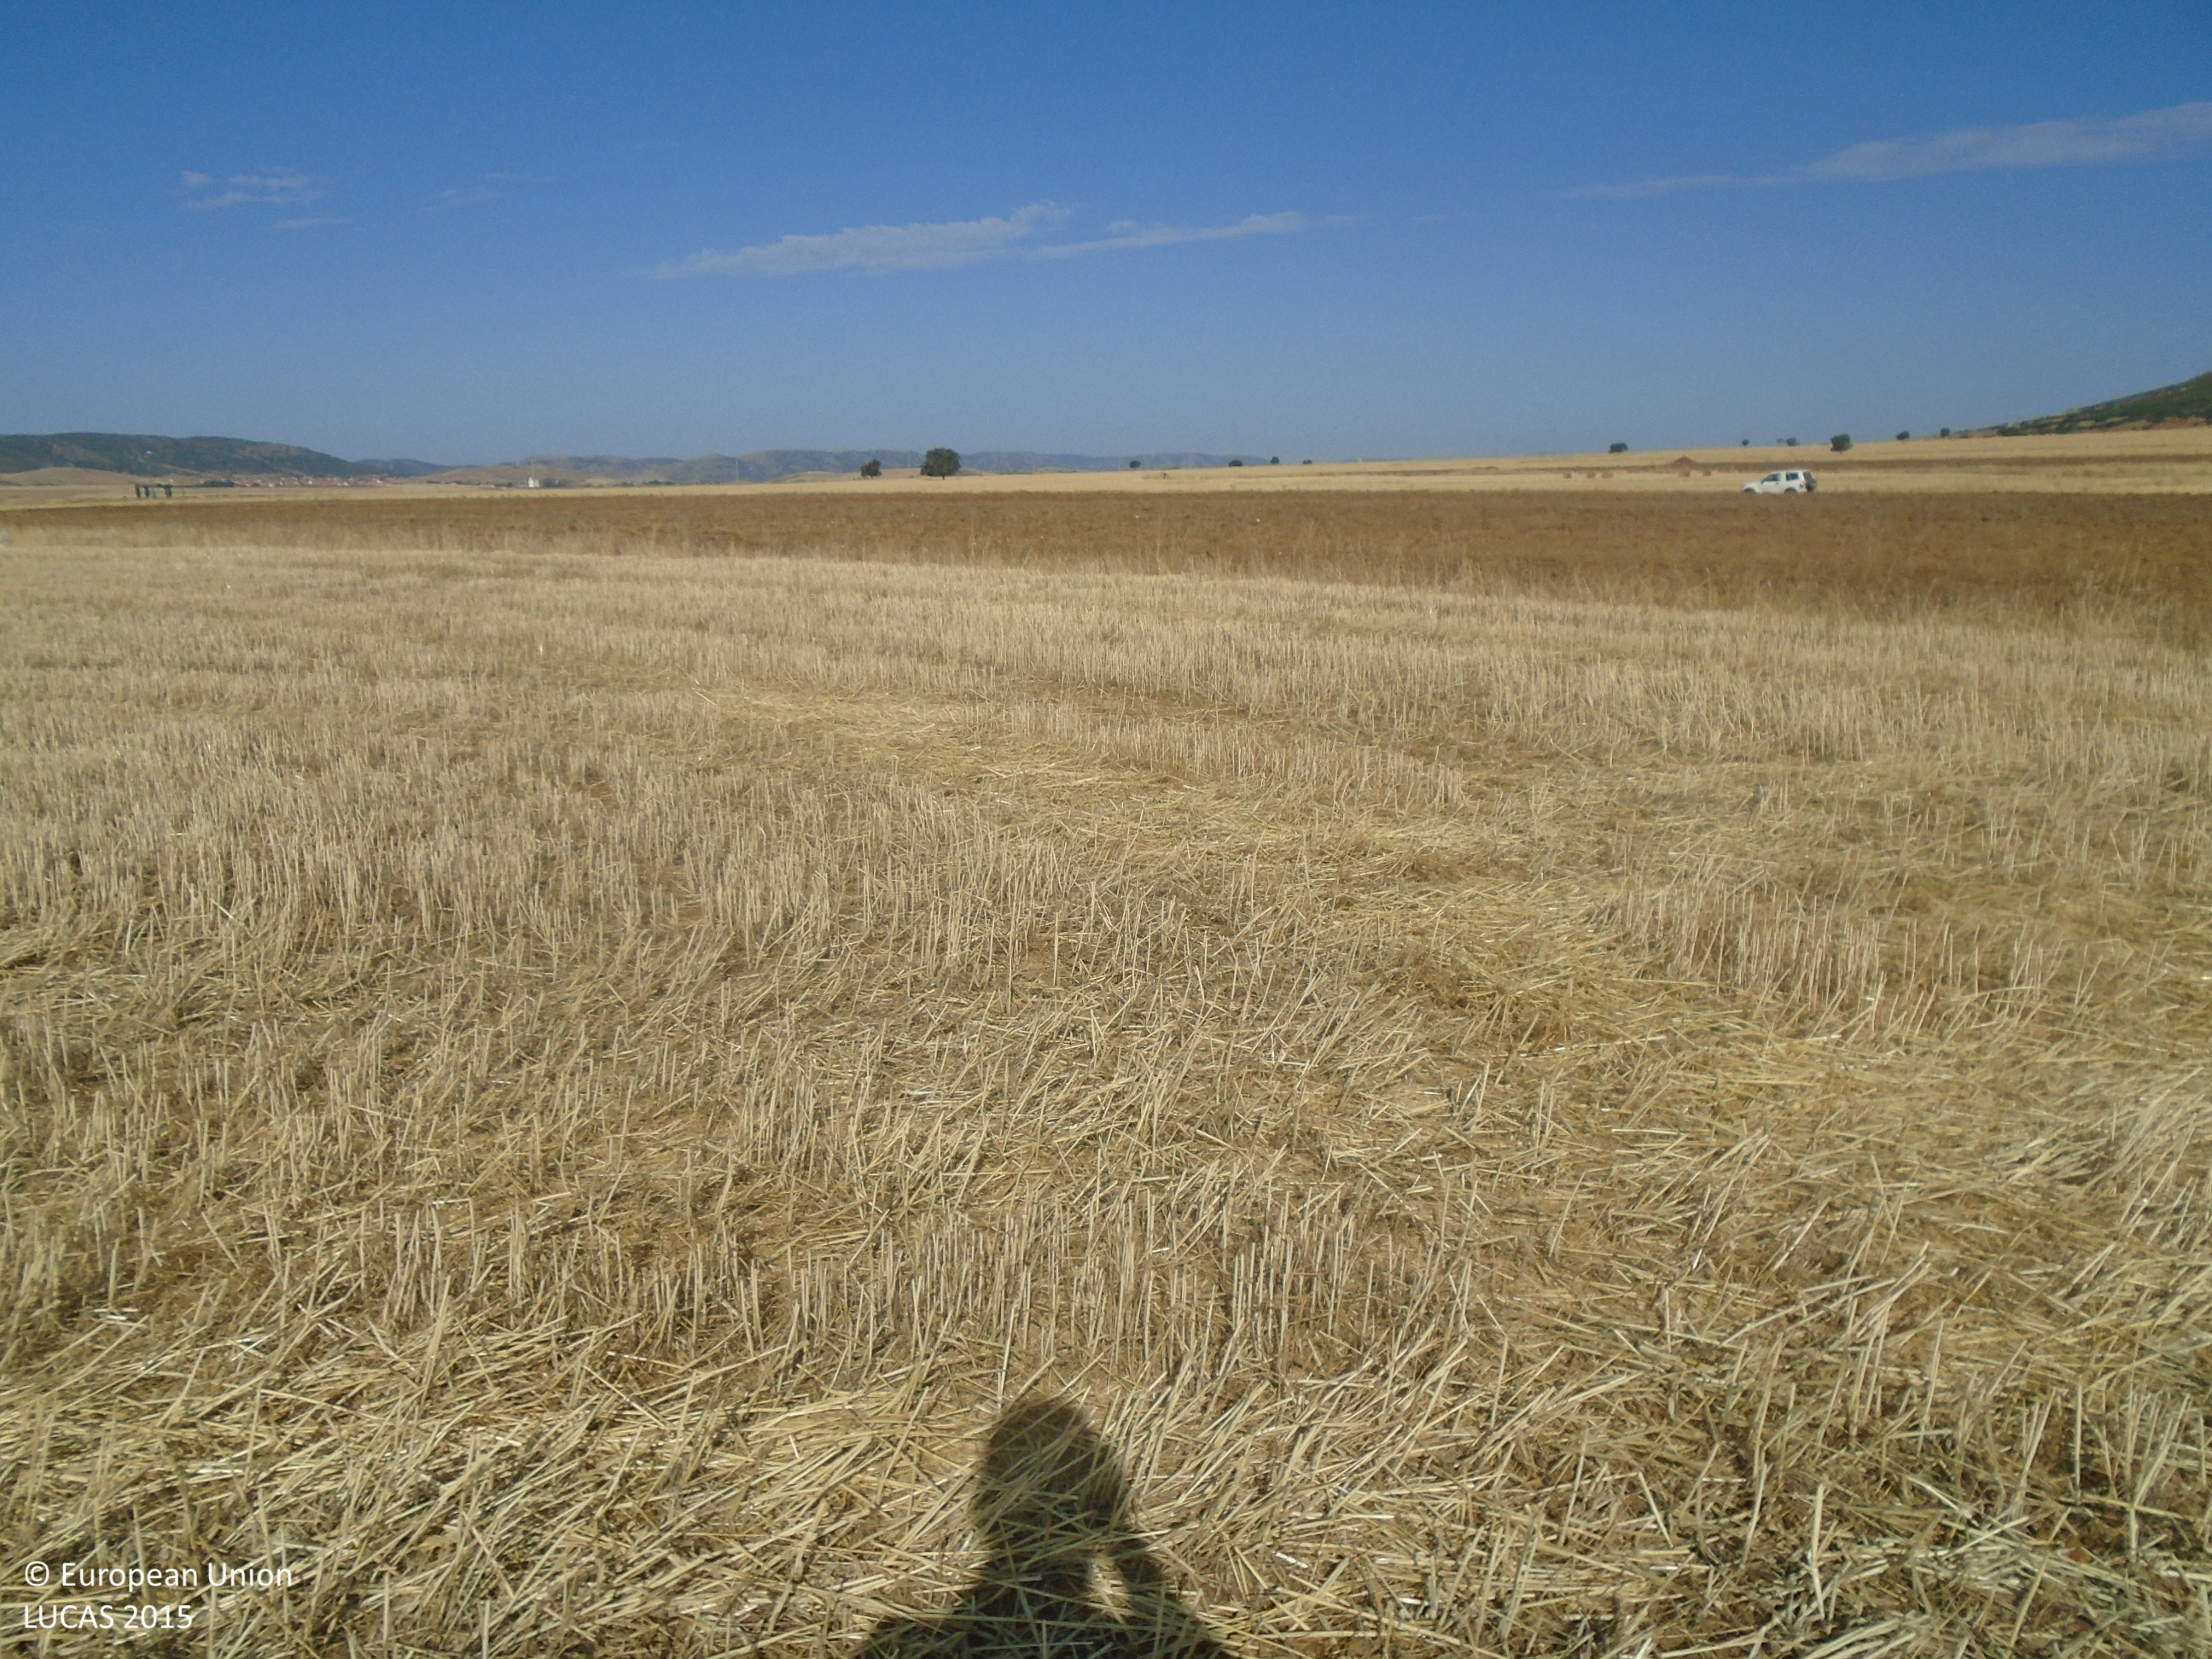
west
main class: Cropland
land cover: Common wheat
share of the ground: < 10 %
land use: Agriculture (excluding fallow land and kitchen gardens)
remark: Harvested field
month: July
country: ES
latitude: 39.1717
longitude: -4.0886
